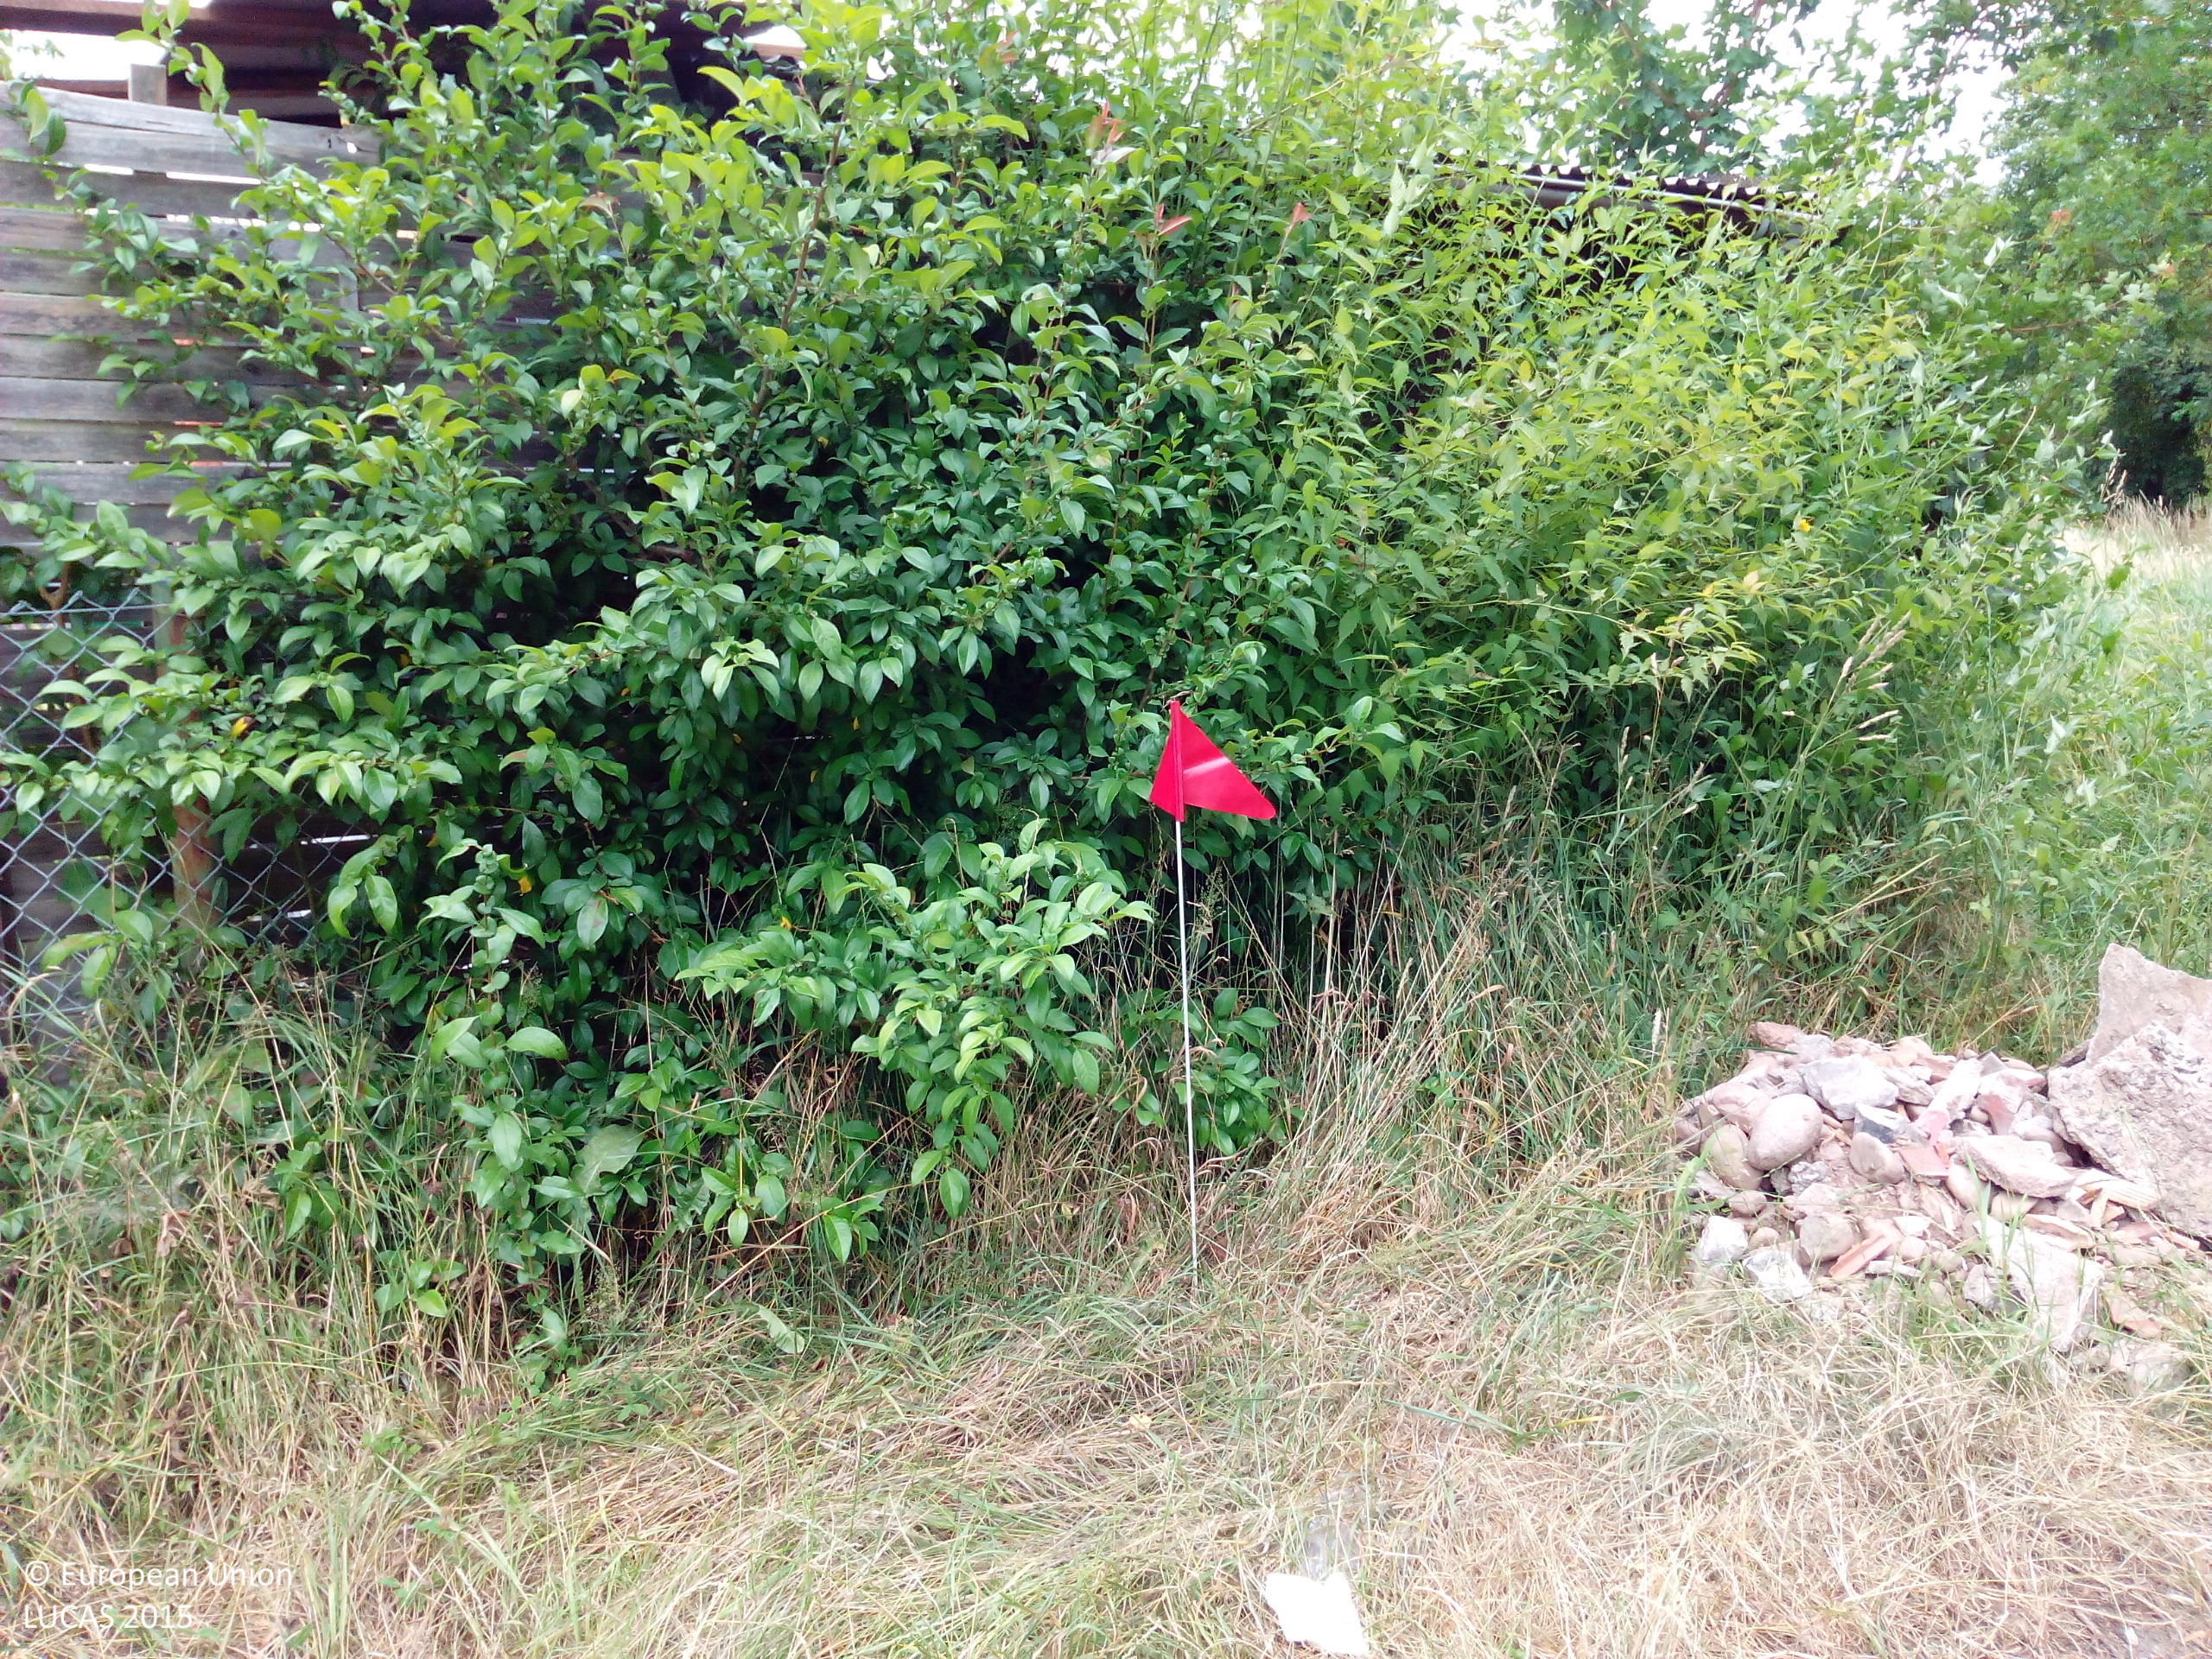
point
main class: Grassland
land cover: Grassland without tree/shrub cover
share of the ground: > 75 %
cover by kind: herbaceous plants 85 %, unconsolidated bare surface 15 %
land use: Kitchen garden
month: July
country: DE
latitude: 47.6414
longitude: 7.6987
